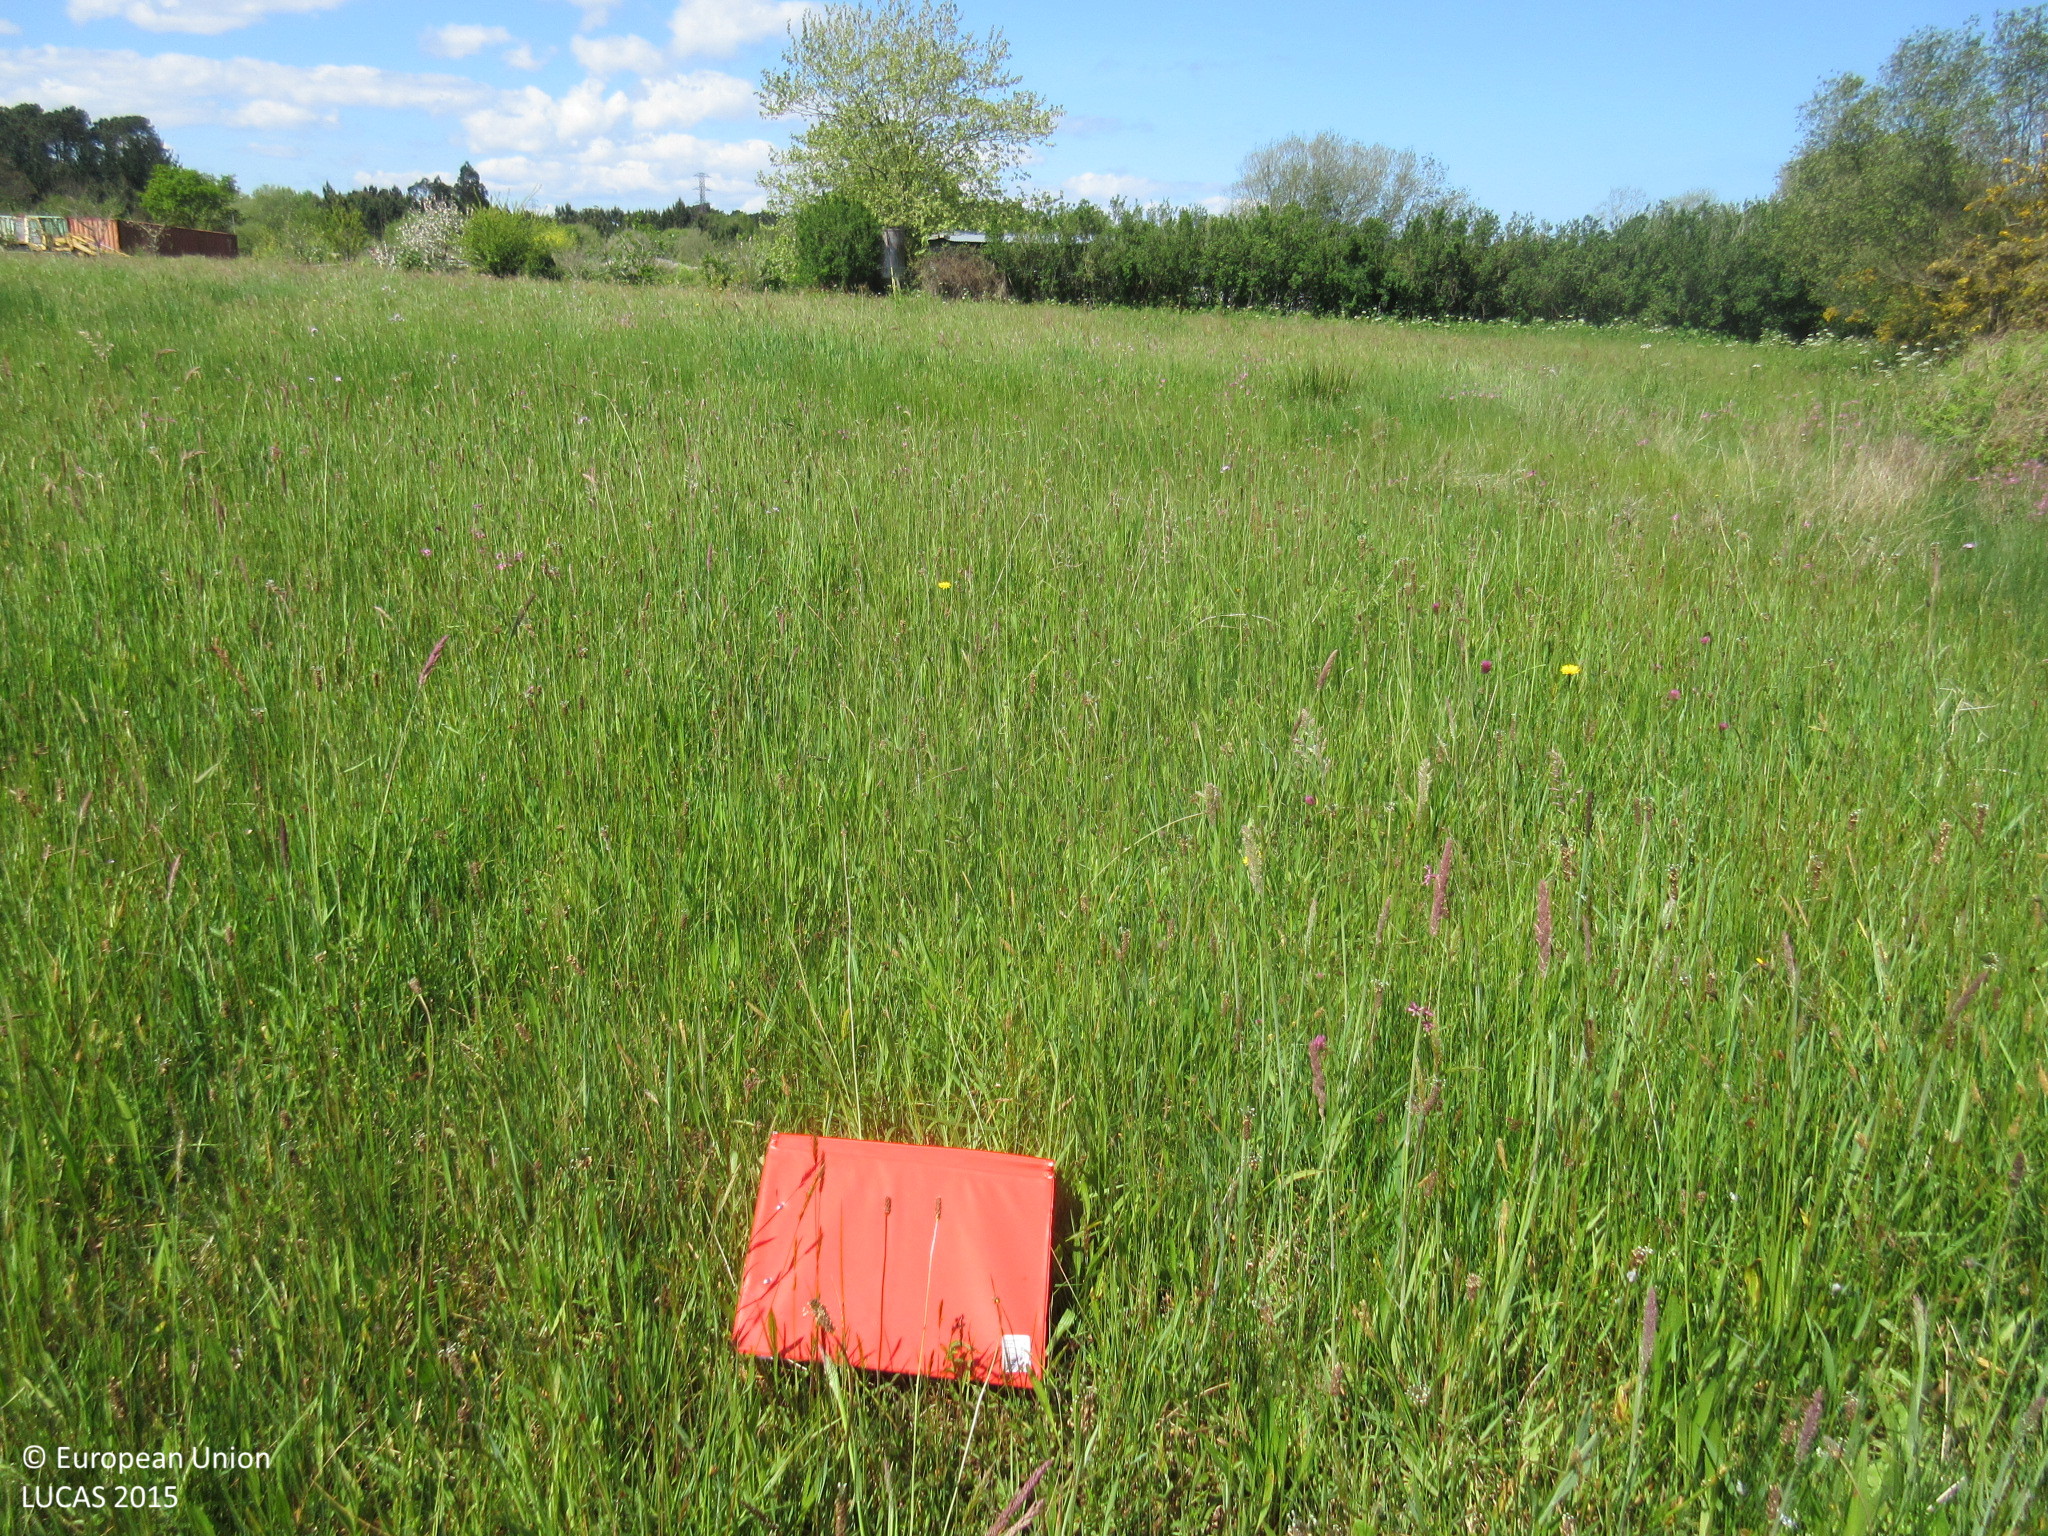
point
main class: Grassland
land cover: Grassland without tree/shrub cover
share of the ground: > 75 %
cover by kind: herbaceous plants 100 %
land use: Agriculture (excluding fallow land and kitchen gardens)
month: April
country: ES
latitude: 43.5272
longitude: -6.9817
